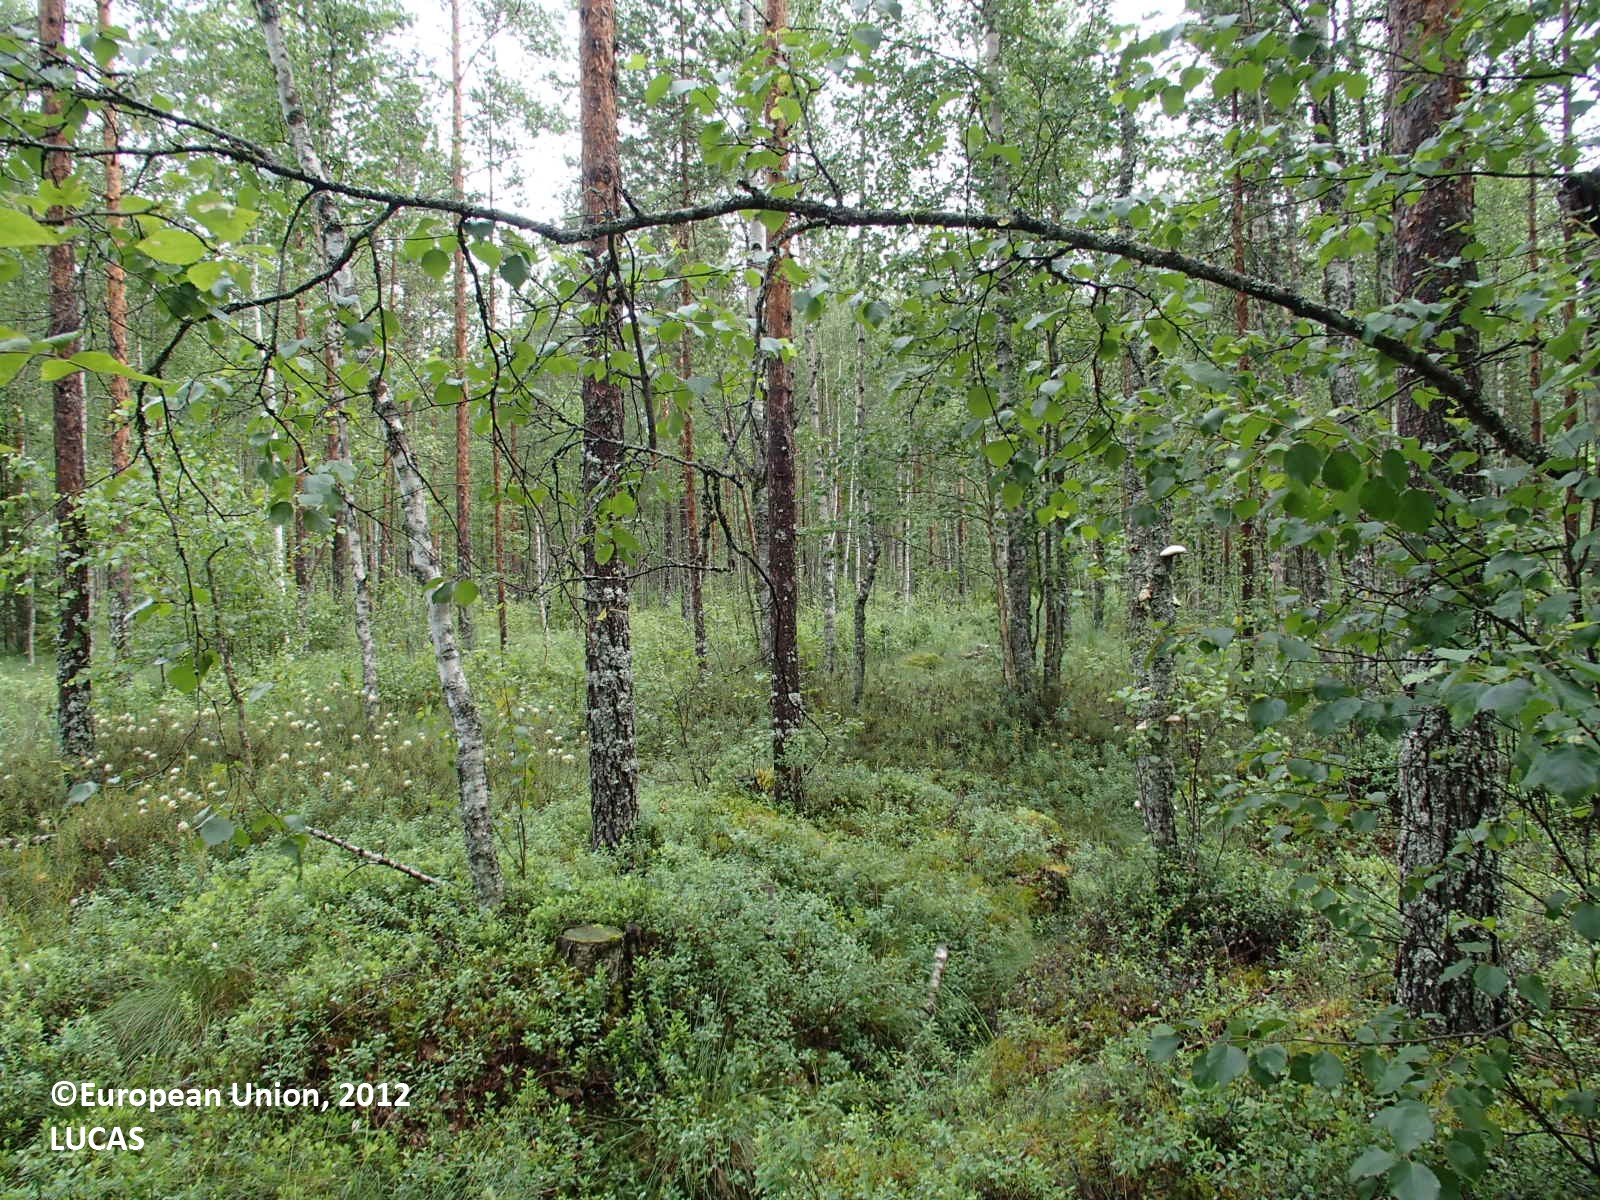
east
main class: Woodland
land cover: Pine dominated mixed woodland
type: boreal forest
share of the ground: > 75 %
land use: Forestry
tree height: > 5 m
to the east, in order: Pine dominated mixed woodland; Tracks; Pine dominated mixed woodland; Ditches and canals; Pine dominated mixed woodland; Ditches and canals; Other mixed woodland; Ditches and canals; Other mixed woodland
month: July
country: FI
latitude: 64.3723
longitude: 26.3796
